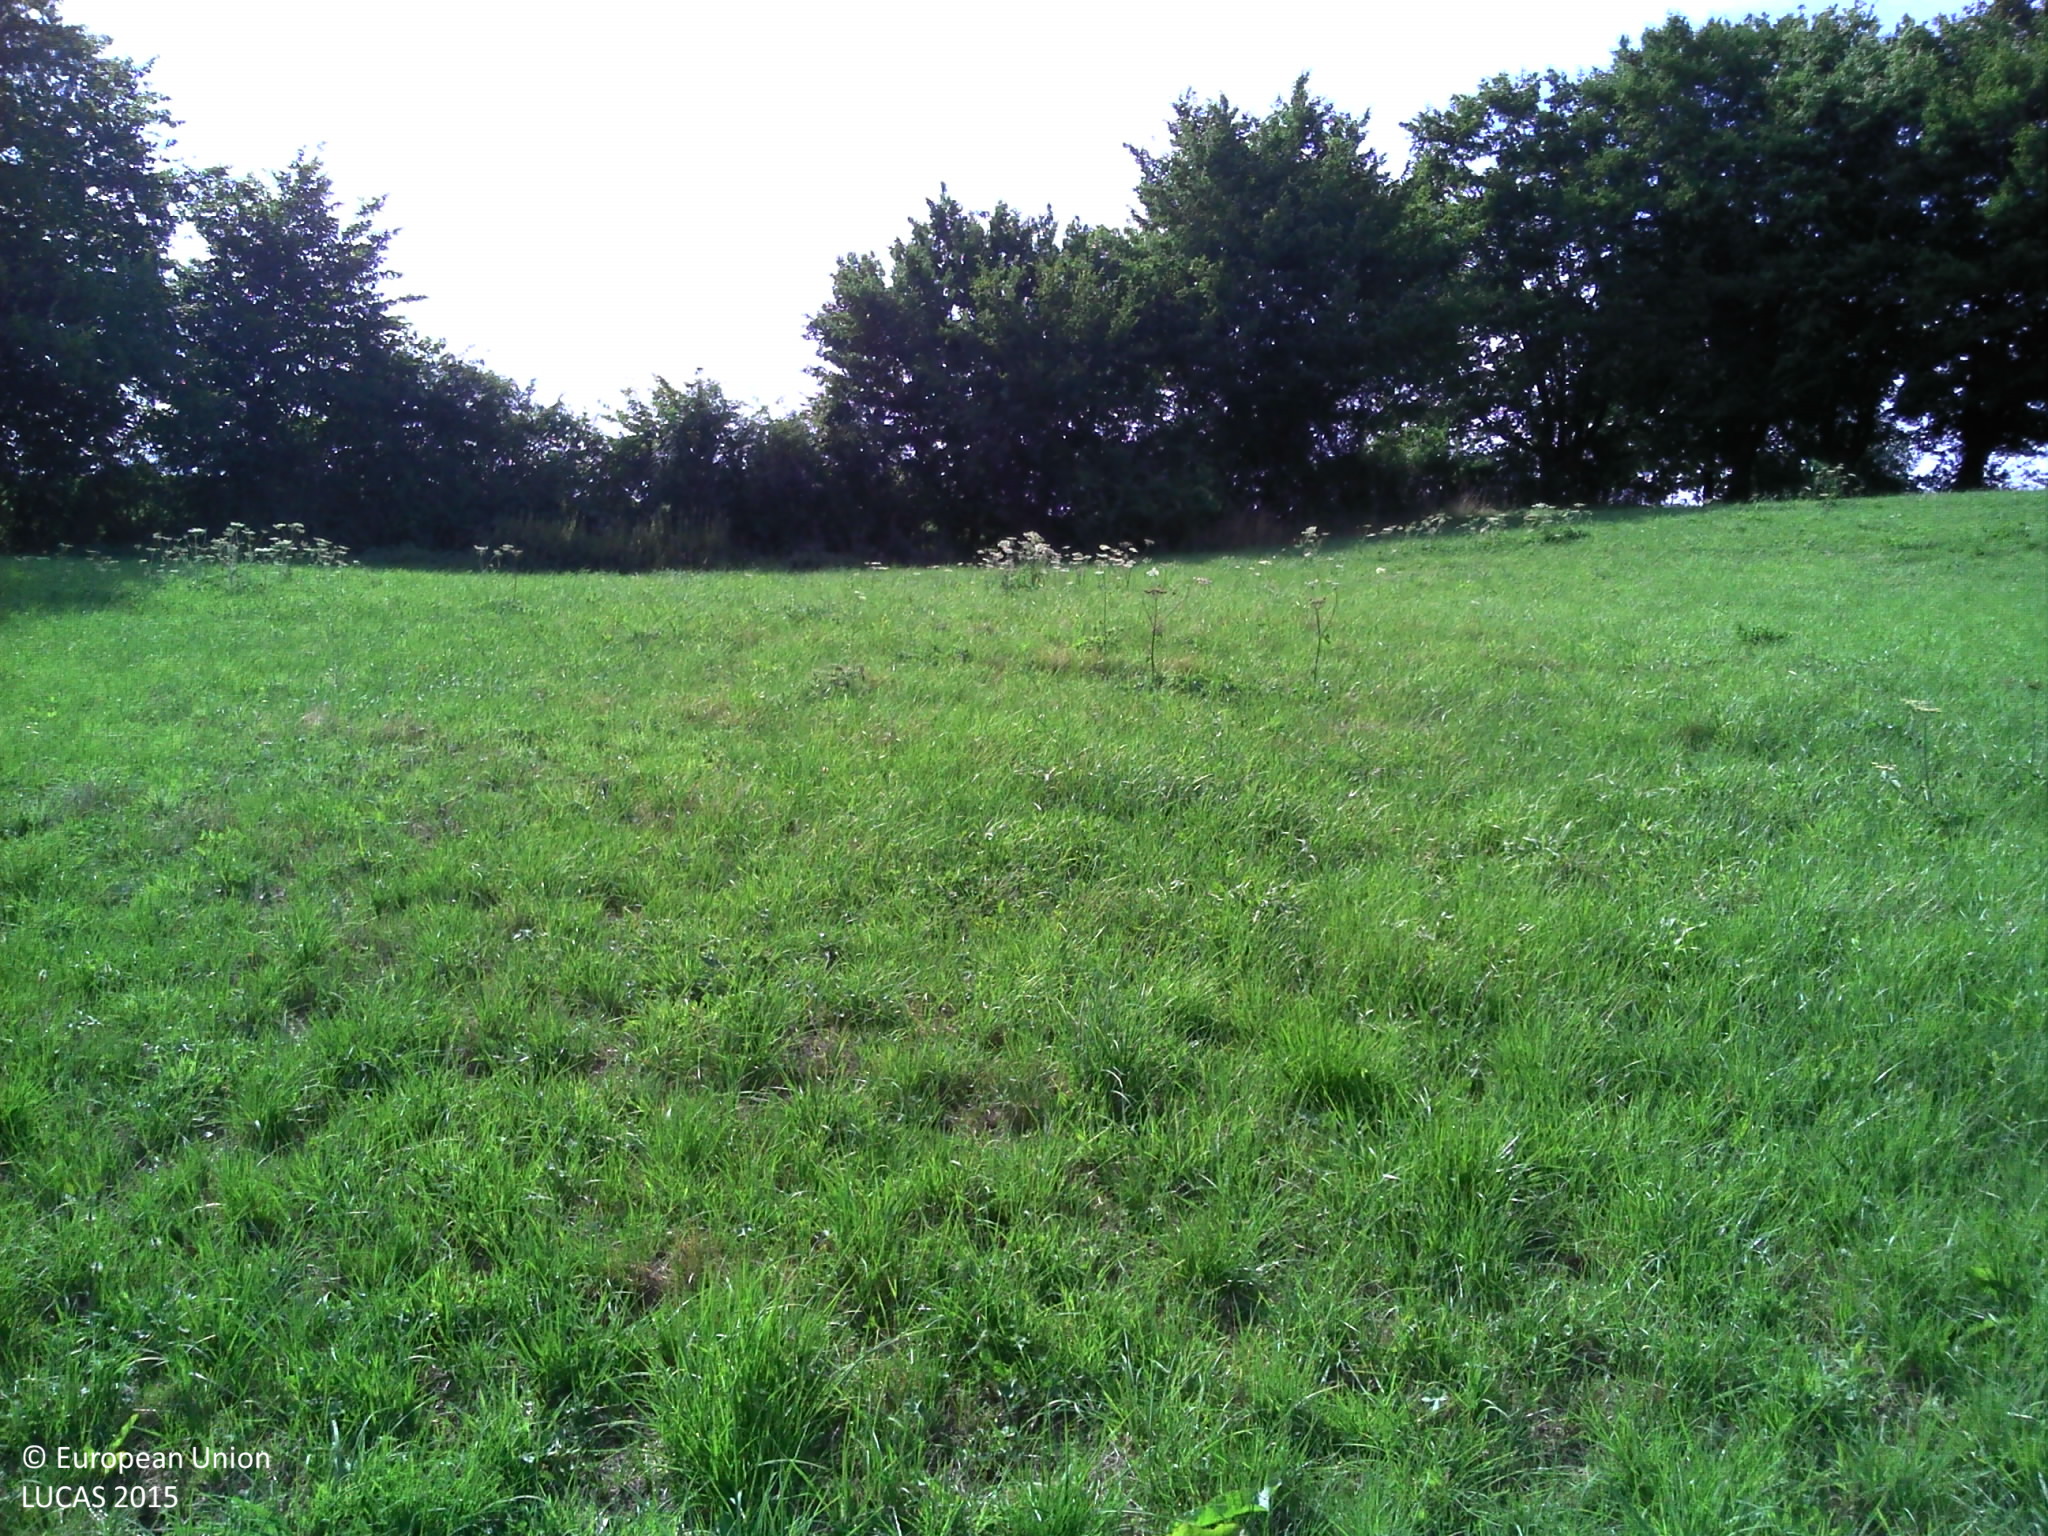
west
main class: Grassland
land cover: Grassland without tree/shrub cover
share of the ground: > 75 %
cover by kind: herbaceous plants 95 %, lichens and mosses 5 %
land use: Agriculture (excluding fallow land and kitchen gardens)
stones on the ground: < 10 %
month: August
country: FR
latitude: 50.0788
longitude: 3.9715
